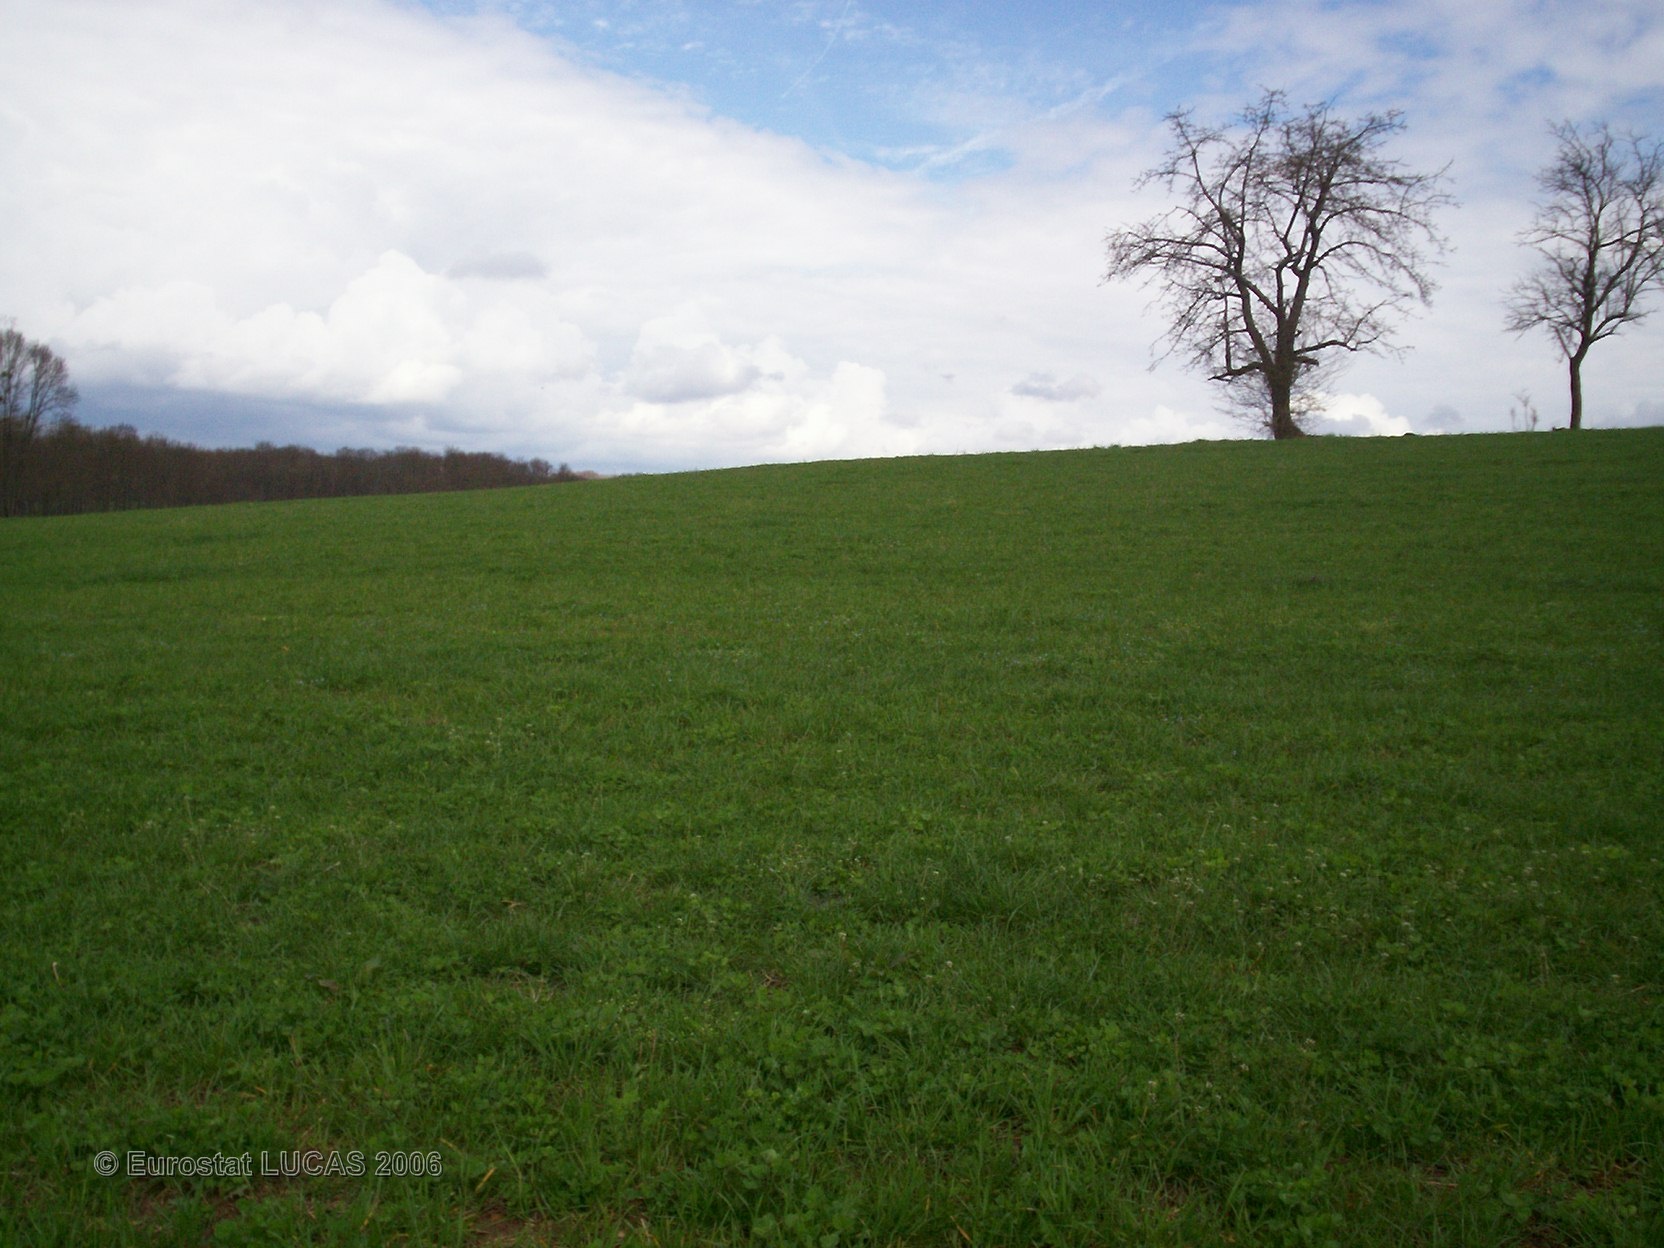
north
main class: Cropland
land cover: Other leguminous and mixtures for fodder
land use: Agriculture (excluding fallow land and kitchen gardens)
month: April
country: FR
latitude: 47.5206
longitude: 6.5354
